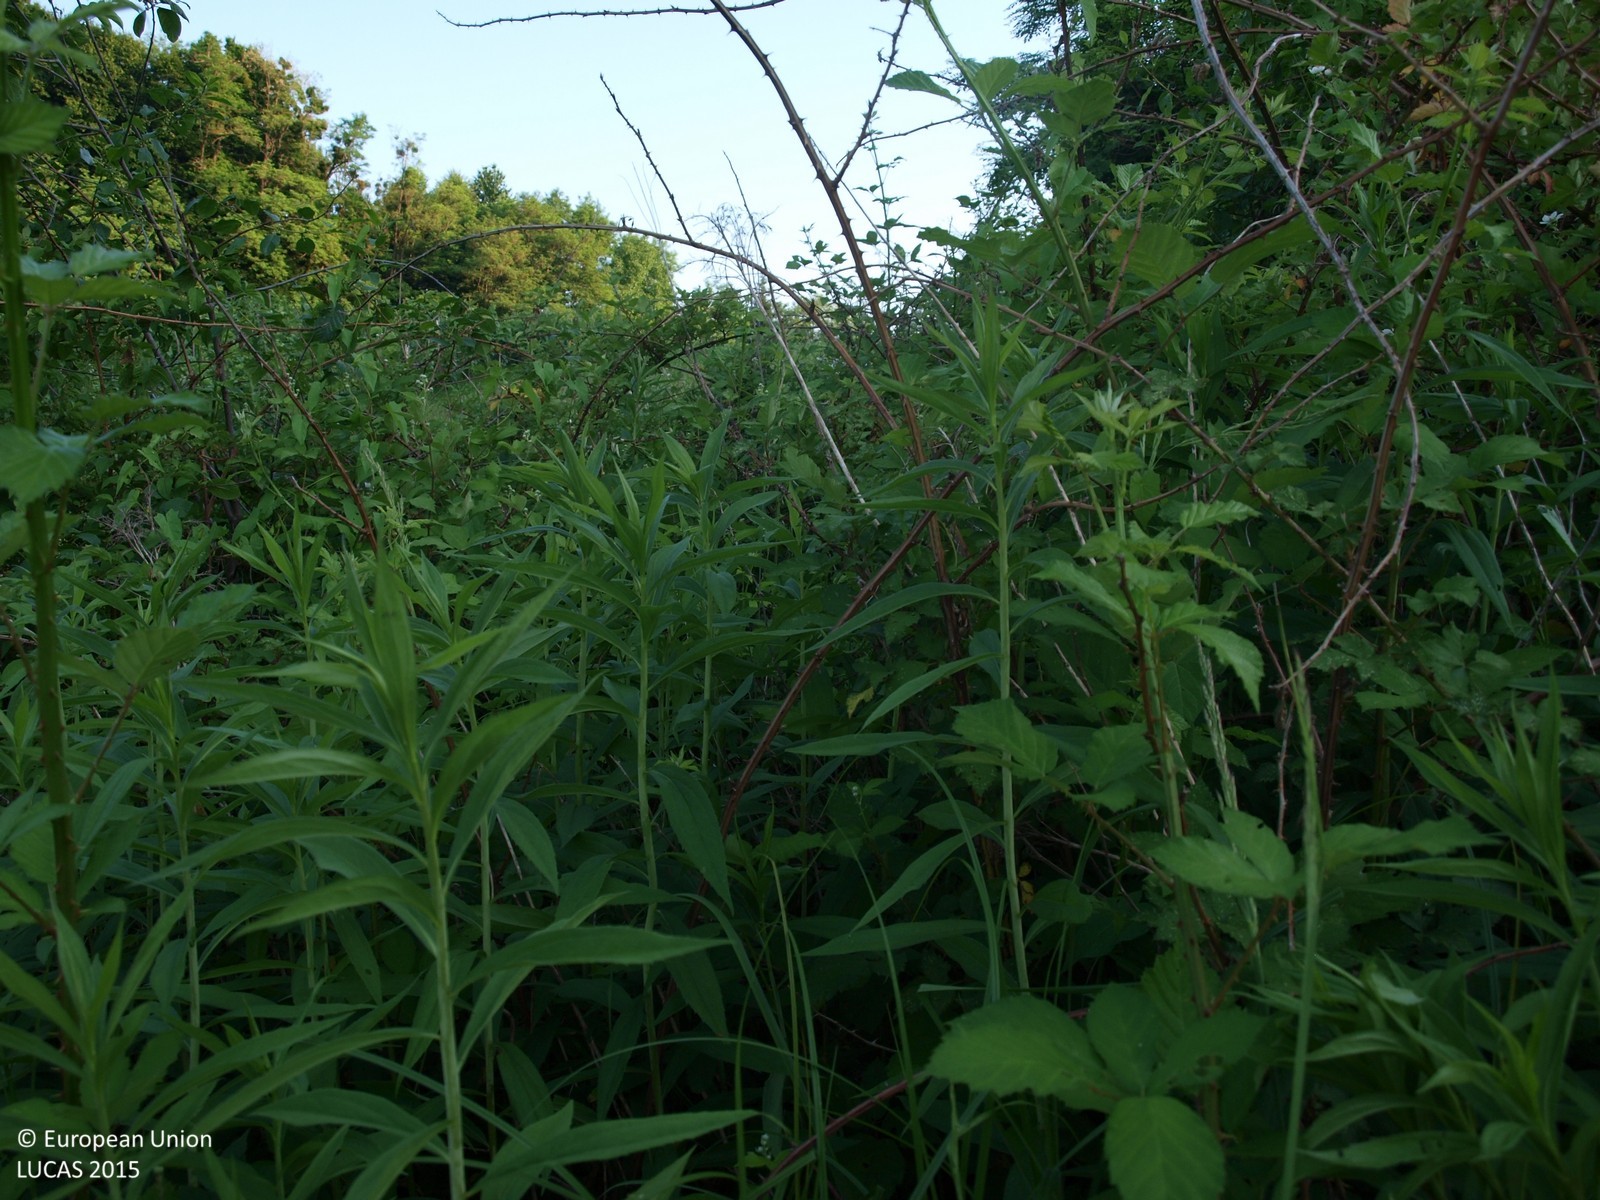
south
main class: Shrubland
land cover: Shrubland with sparse tree cover
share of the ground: > 75 %
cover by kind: shrubs 85 %, herbaceous plants 10 %, broadleaved forest trees 5 %
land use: Semi-natural and natural areas not in use
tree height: < 5 m
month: June
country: HR
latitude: 46.2174
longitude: 16.0270
